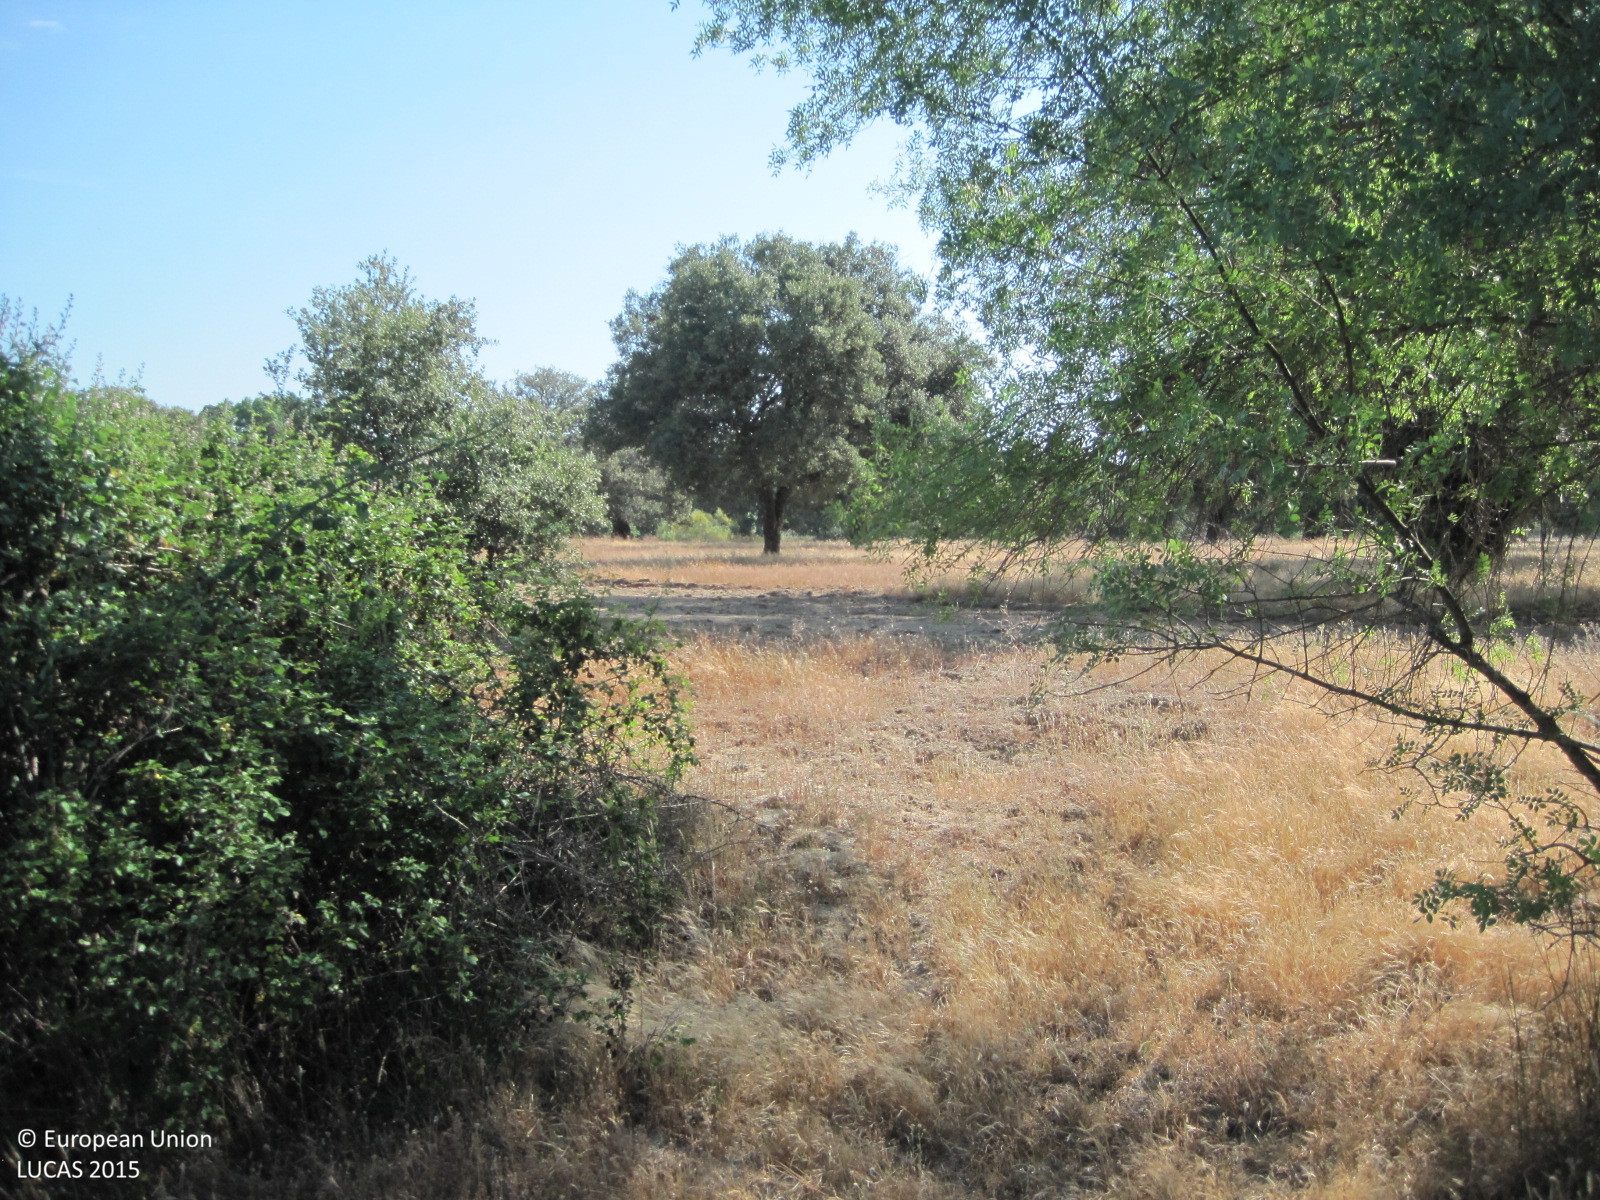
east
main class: Woodland
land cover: Broadleaved woodland
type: broadleaved evergreen forest
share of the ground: 25 - 50 %
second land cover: Grassland without tree/shrub cover
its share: 50 - 75 %
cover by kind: herbaceous plants 55 %, broadleaved forest trees 45 %
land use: Forestry
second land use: Agriculture (excluding fallow land and kitchen gardens)
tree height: > 5 m
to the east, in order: Broadleaved woodland; Grassland without tree/shrub cover; Fences; Broadleaved woodland
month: June
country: ES
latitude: 40.0441
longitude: -4.9957
